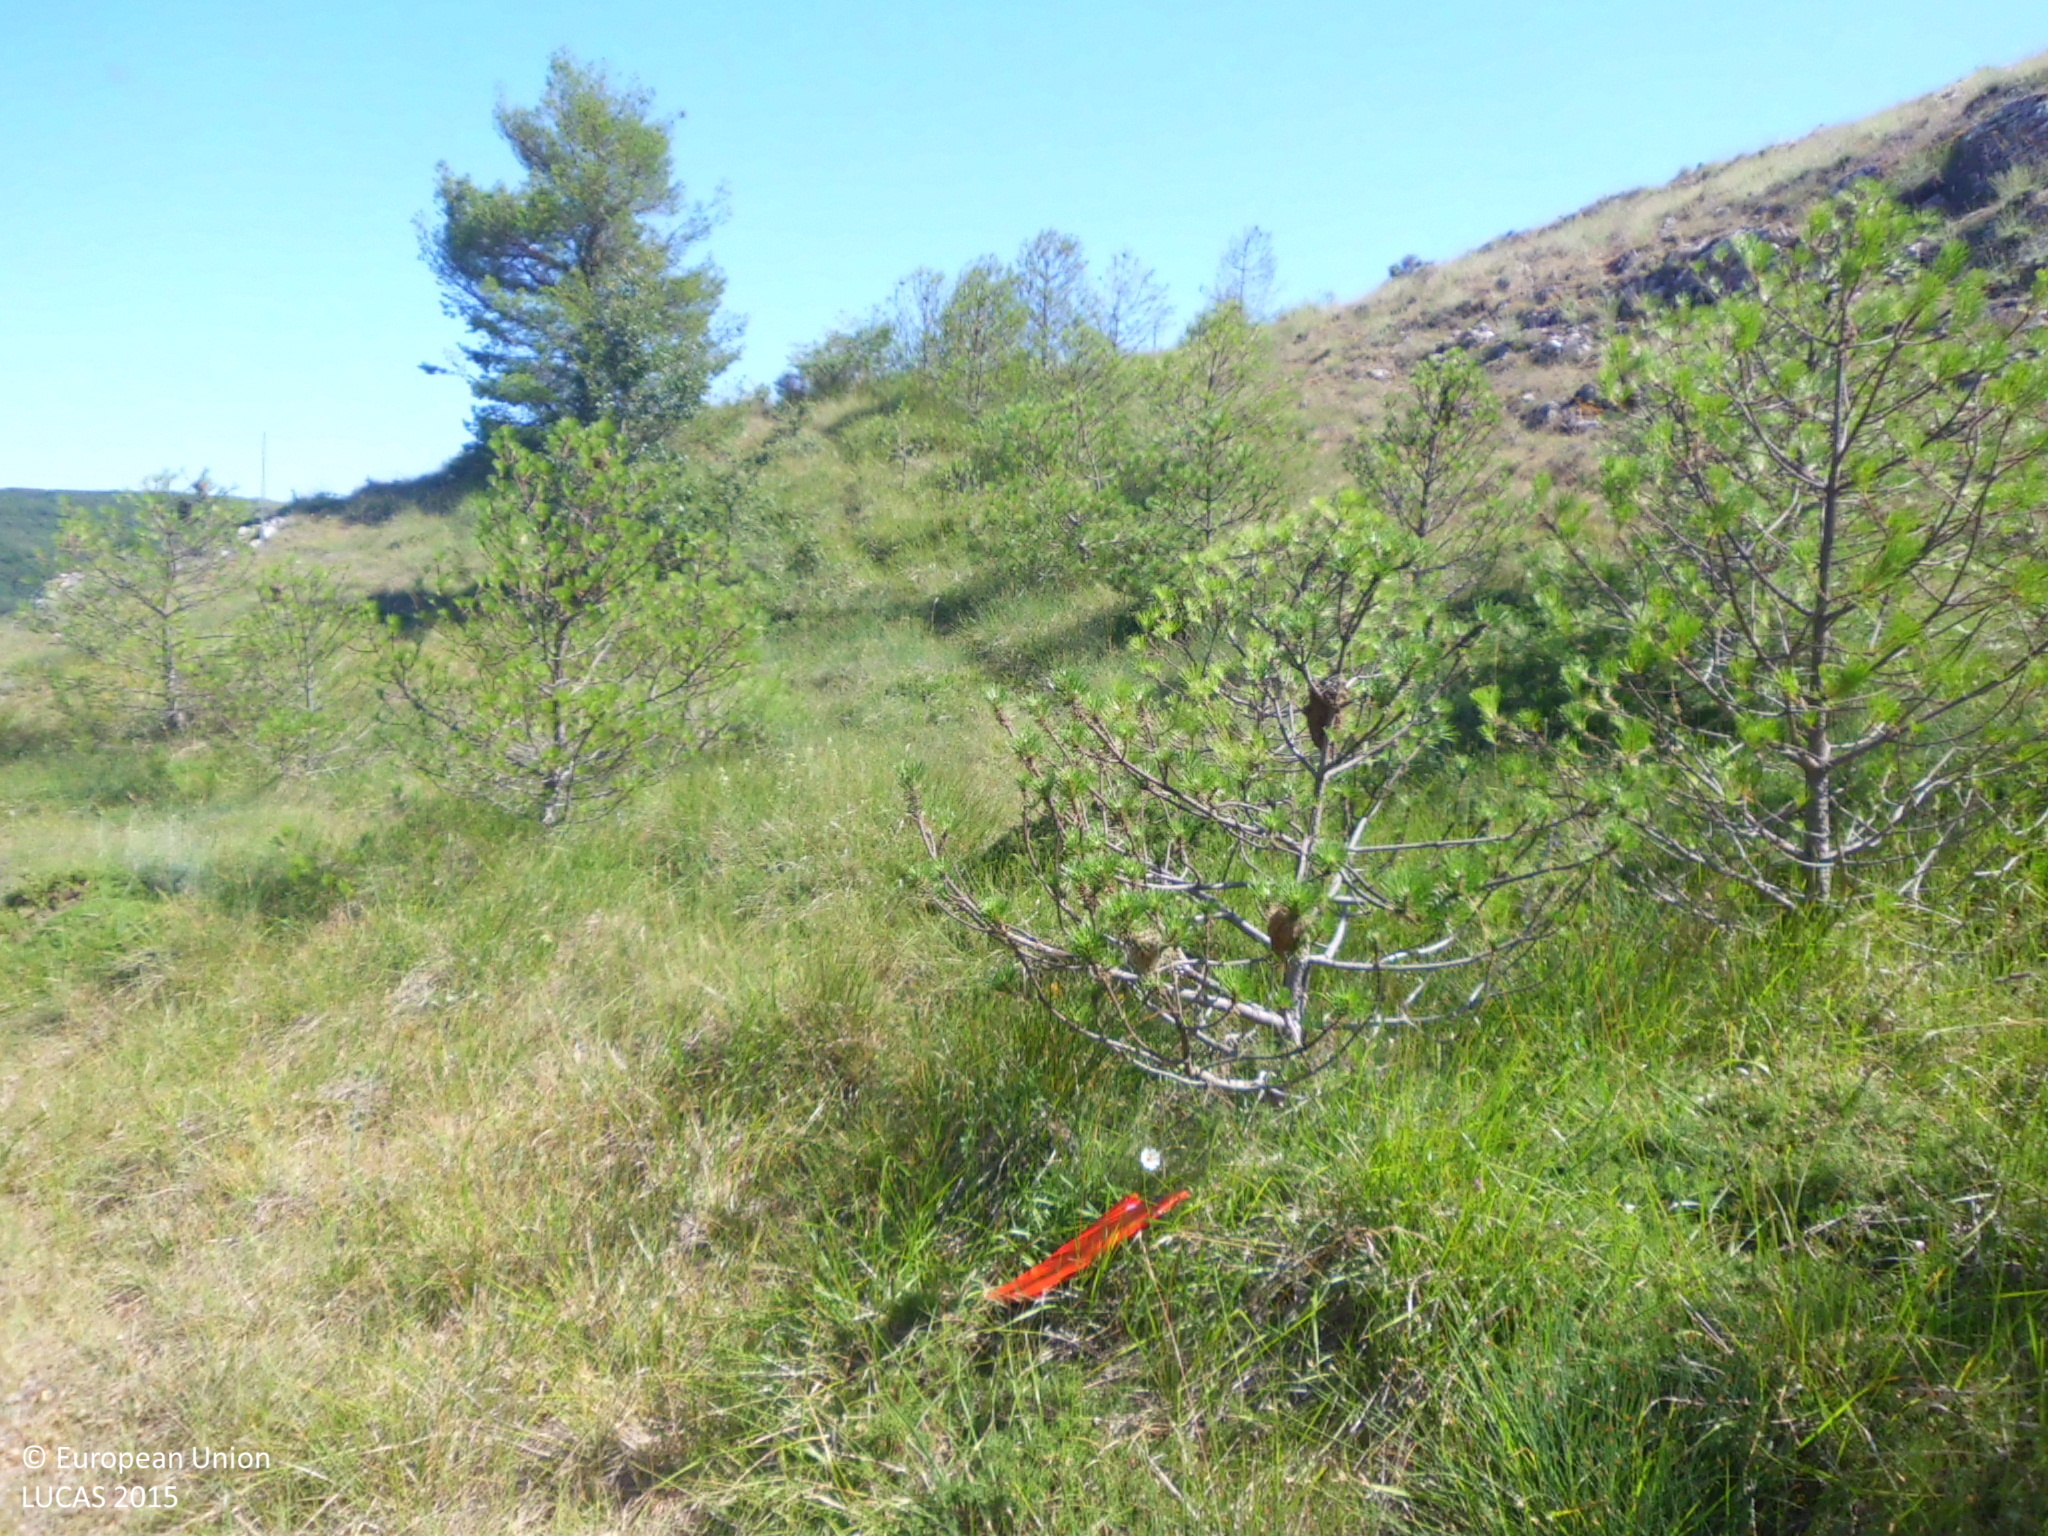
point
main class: Woodland
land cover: Pine dominated coniferous woodland
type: coniferous forest of the mediterranean region
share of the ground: 25 - 50 %
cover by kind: coniferous forest trees 40 %, shrubs 25 %, herbaceous plants 25 %, consolidated bare surface 10 %
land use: Forestry
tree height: < 5 m
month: July
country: ES
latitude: 42.7811
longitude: -4.3405
